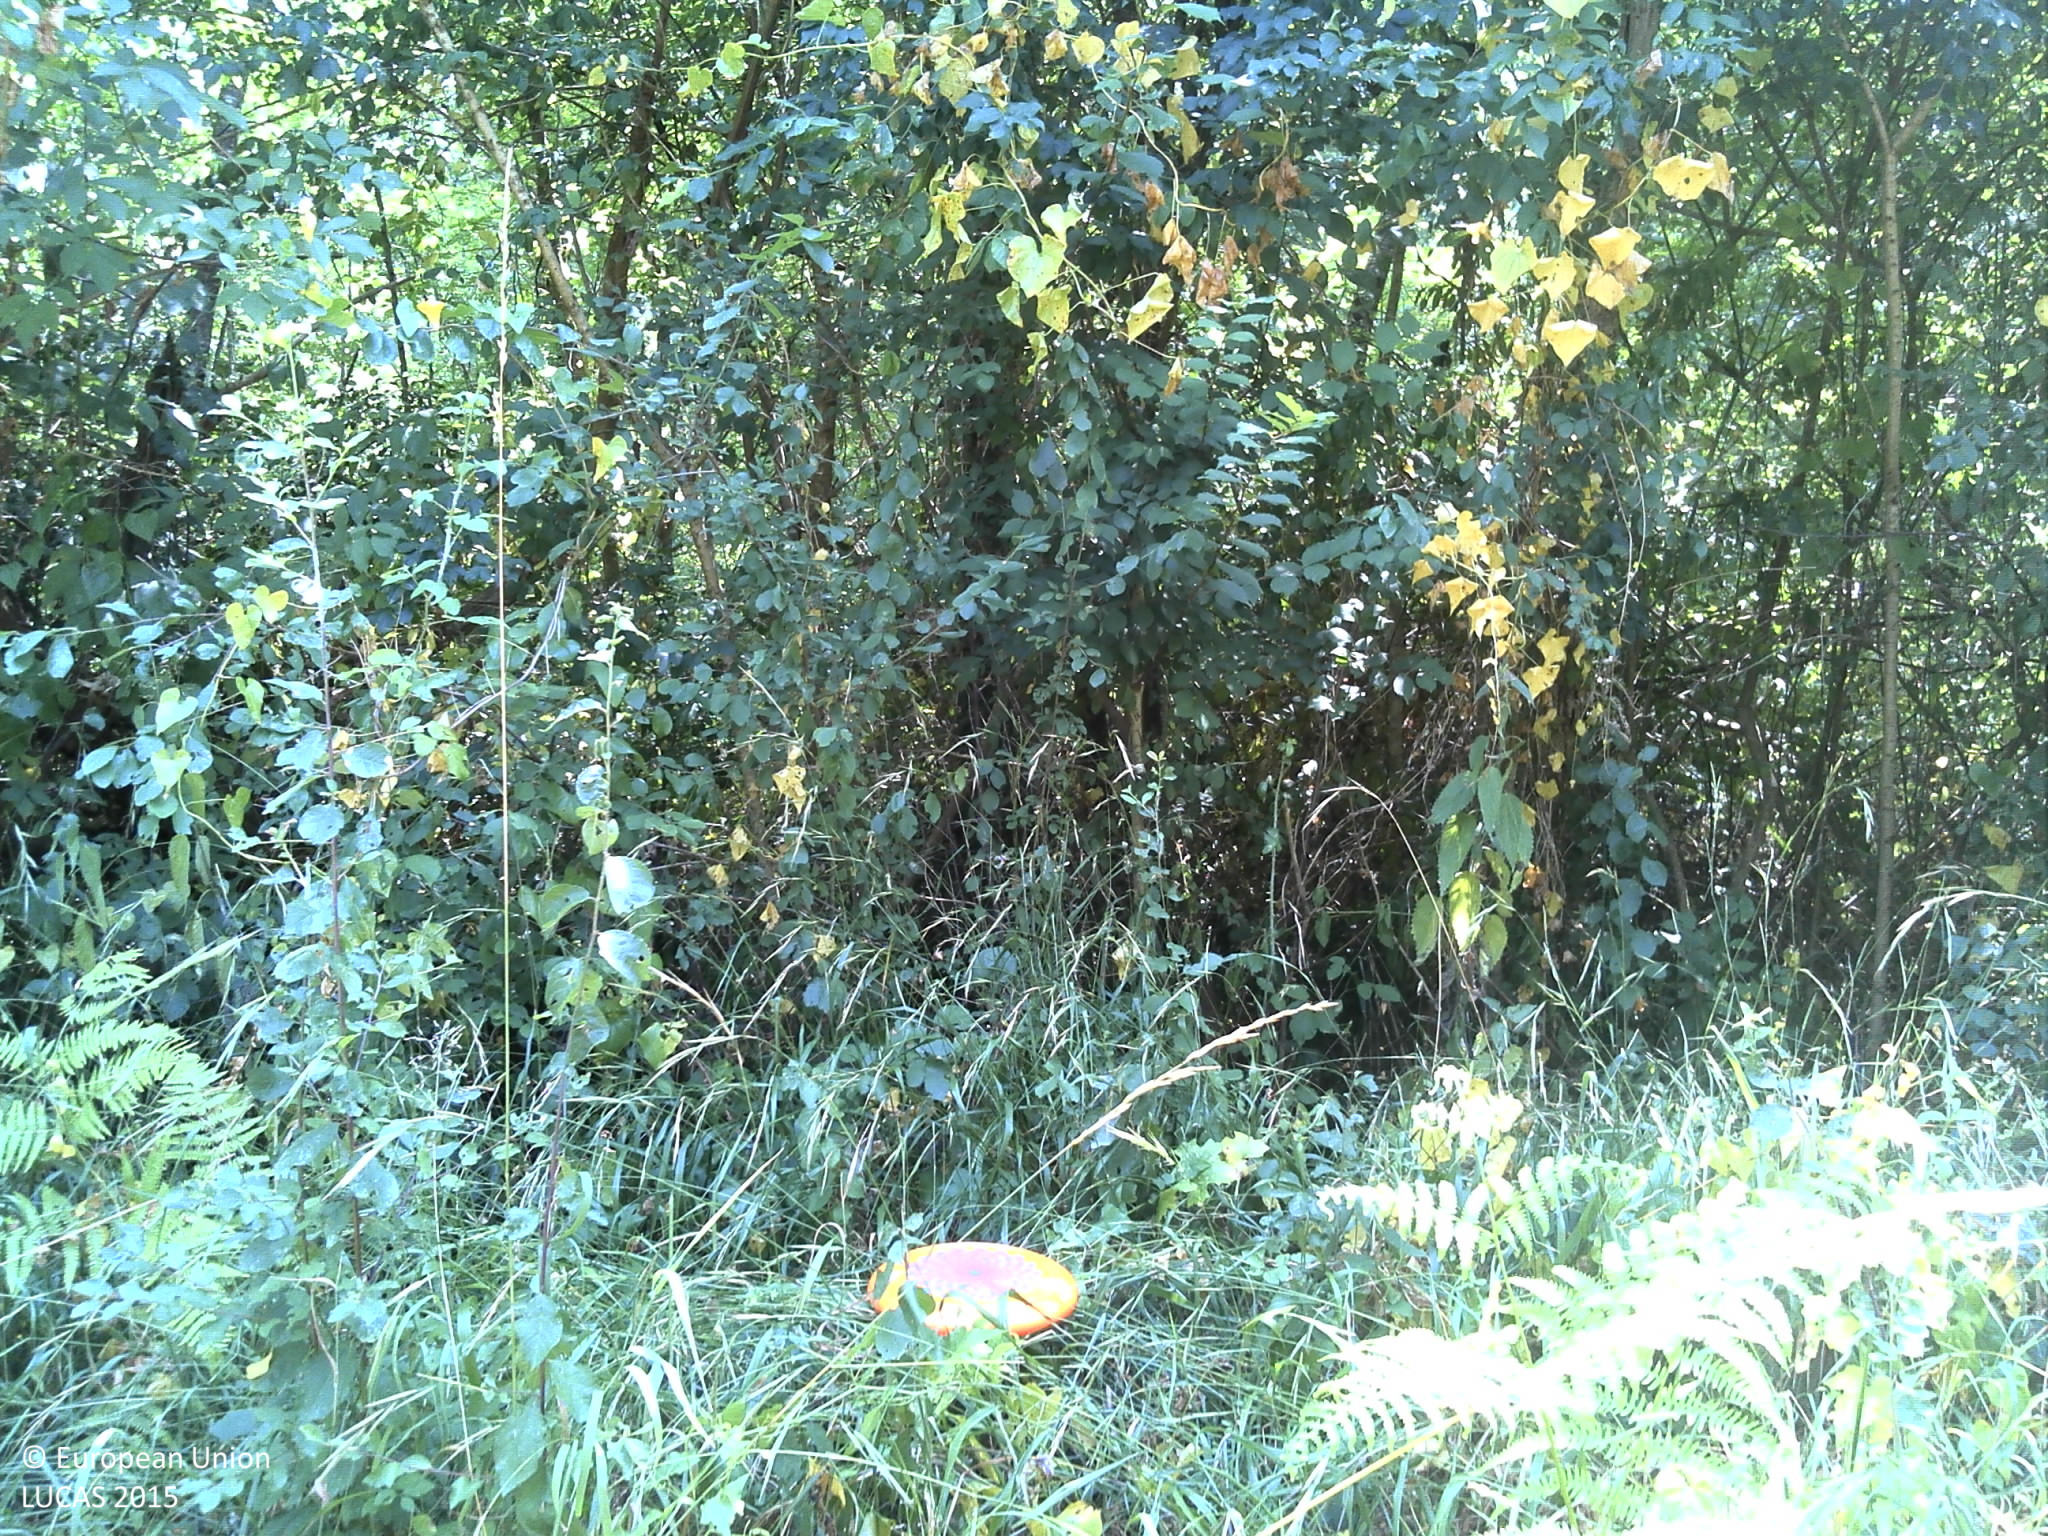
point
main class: Woodland
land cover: Broadleaved woodland
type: mesophytic deciduous forest
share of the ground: > 75 %
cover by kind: broadleaved forest trees 80 %, shrubs 10 %, coniferous forest trees 5 %, herbaceous plants 5 %
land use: Forestry
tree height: > 5 m
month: July
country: FR
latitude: 44.6450
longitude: -0.3923
